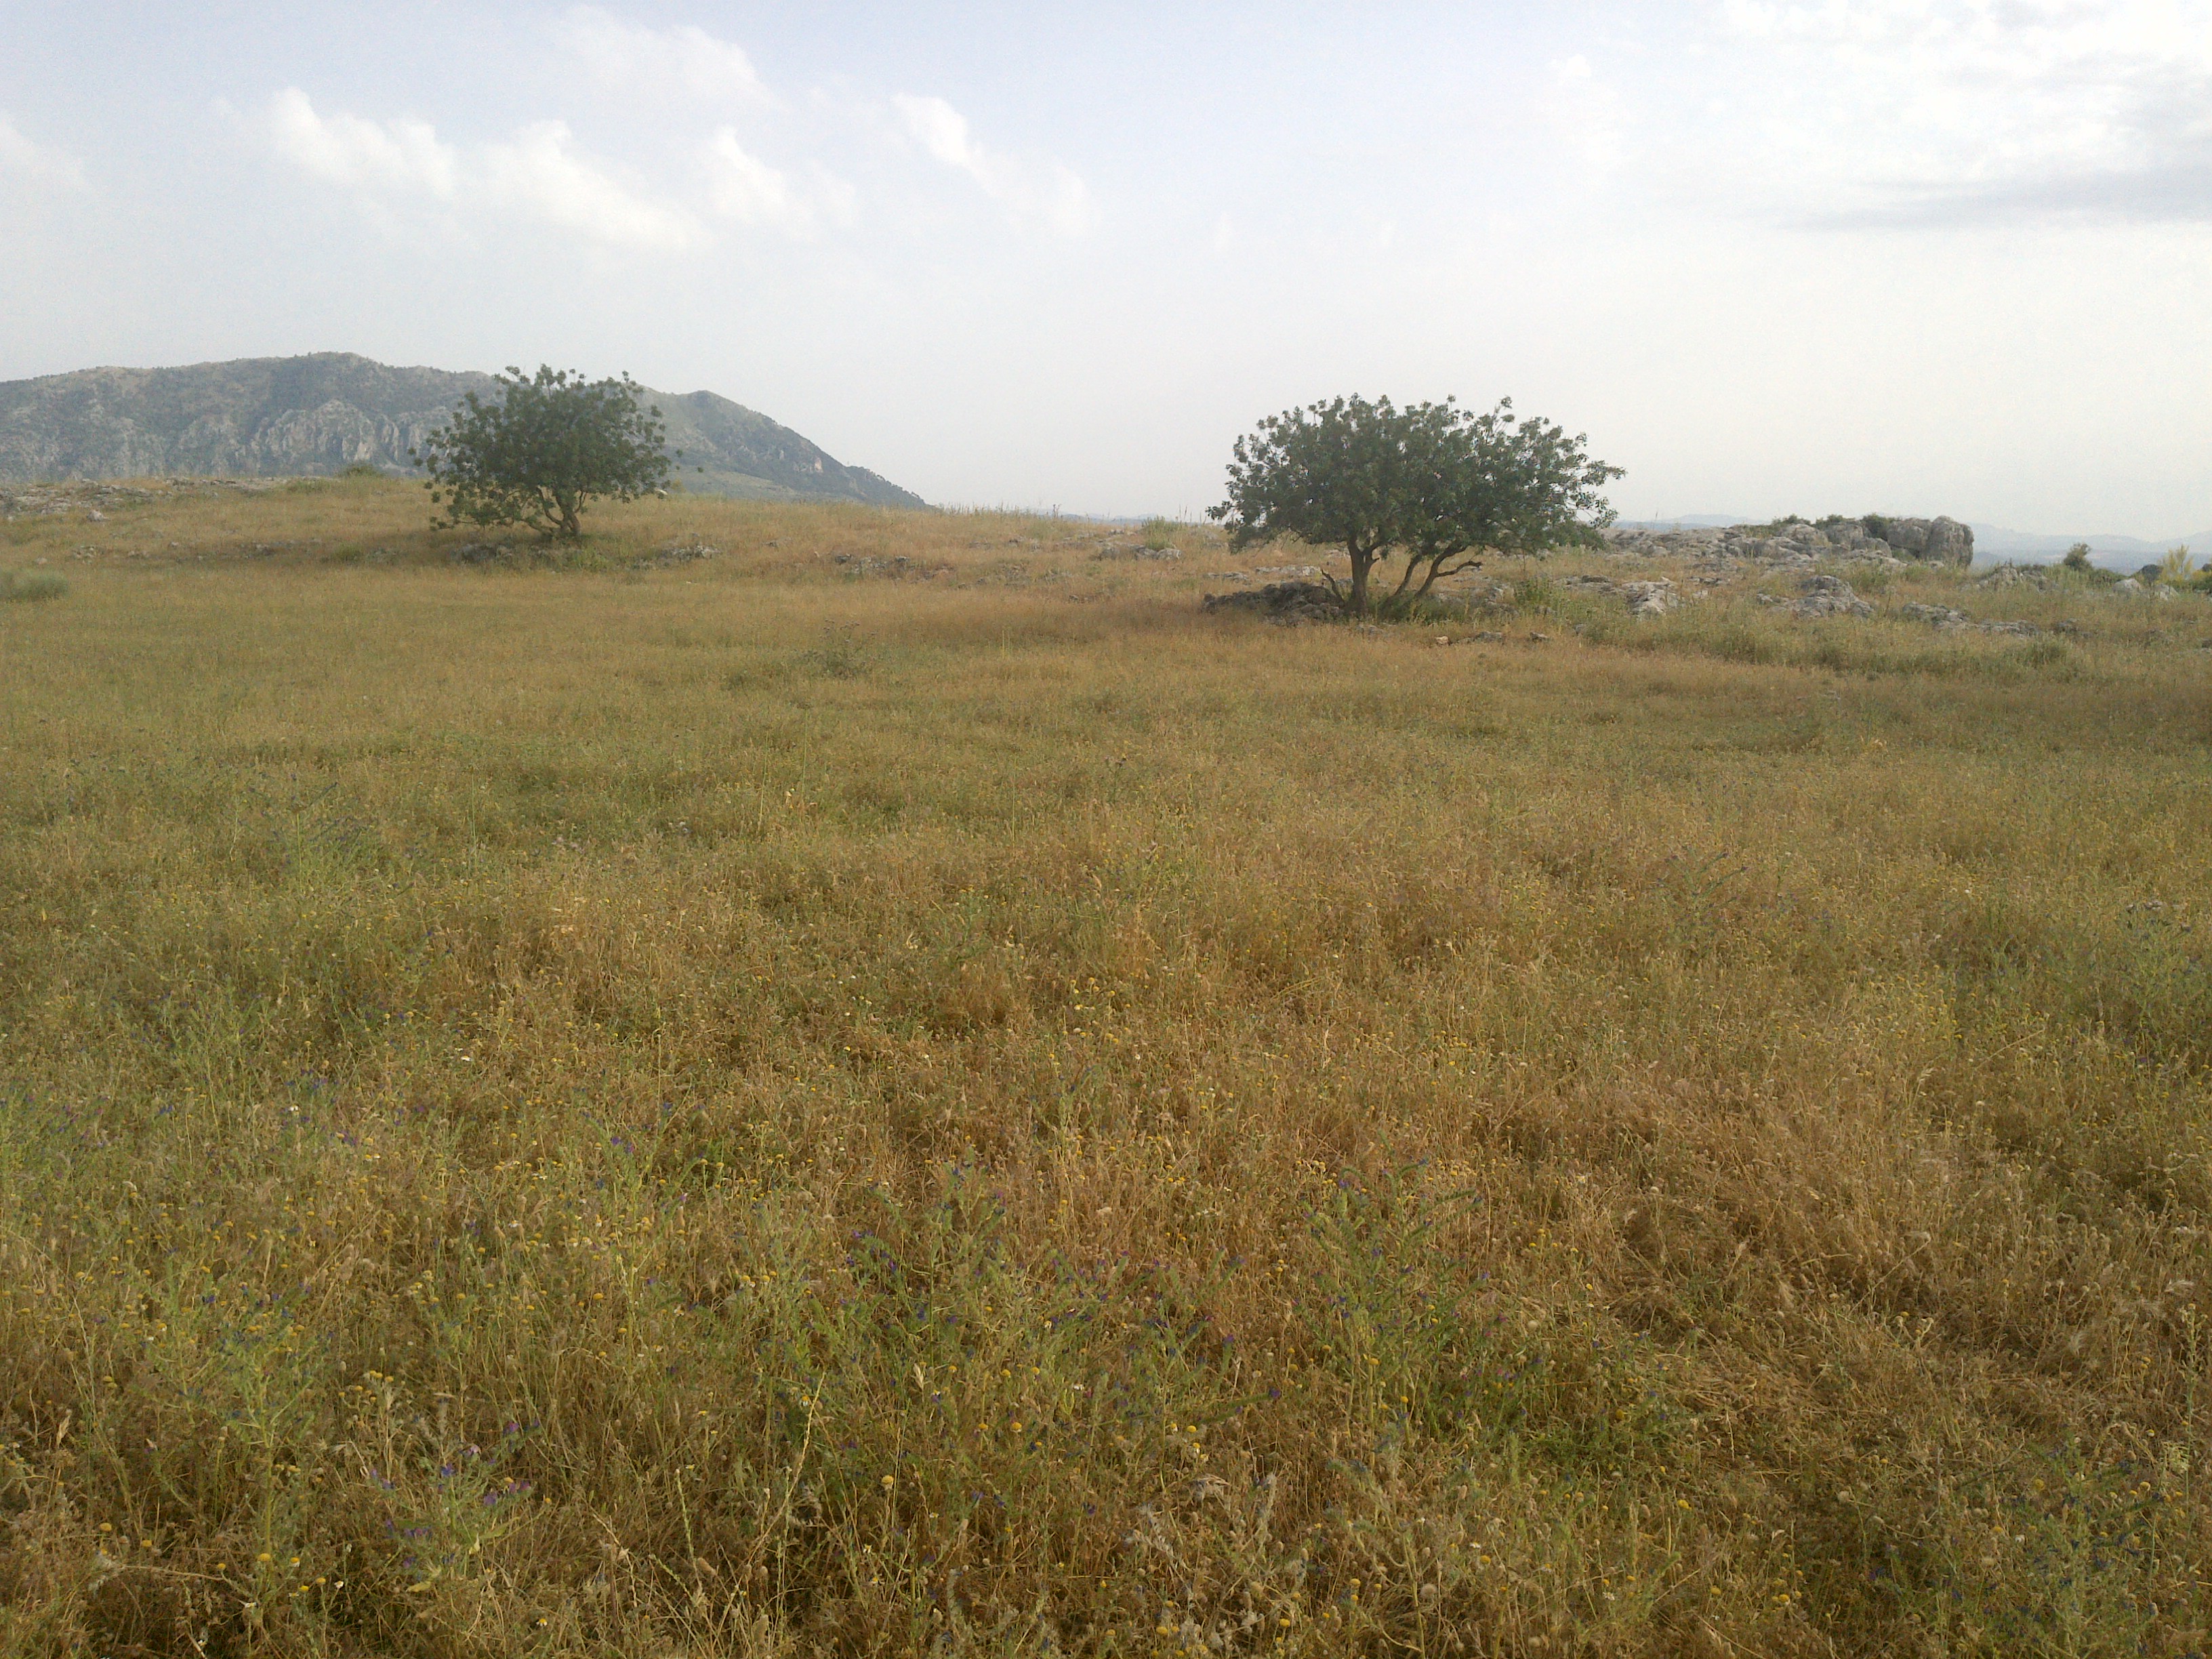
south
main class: Grassland
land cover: Grassland without tree/shrub cover
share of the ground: > 75 %
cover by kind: herbaceous plants 100 %
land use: Agriculture (excluding fallow land and kitchen gardens)
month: May
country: ES
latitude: 37.4053
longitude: -4.3599
